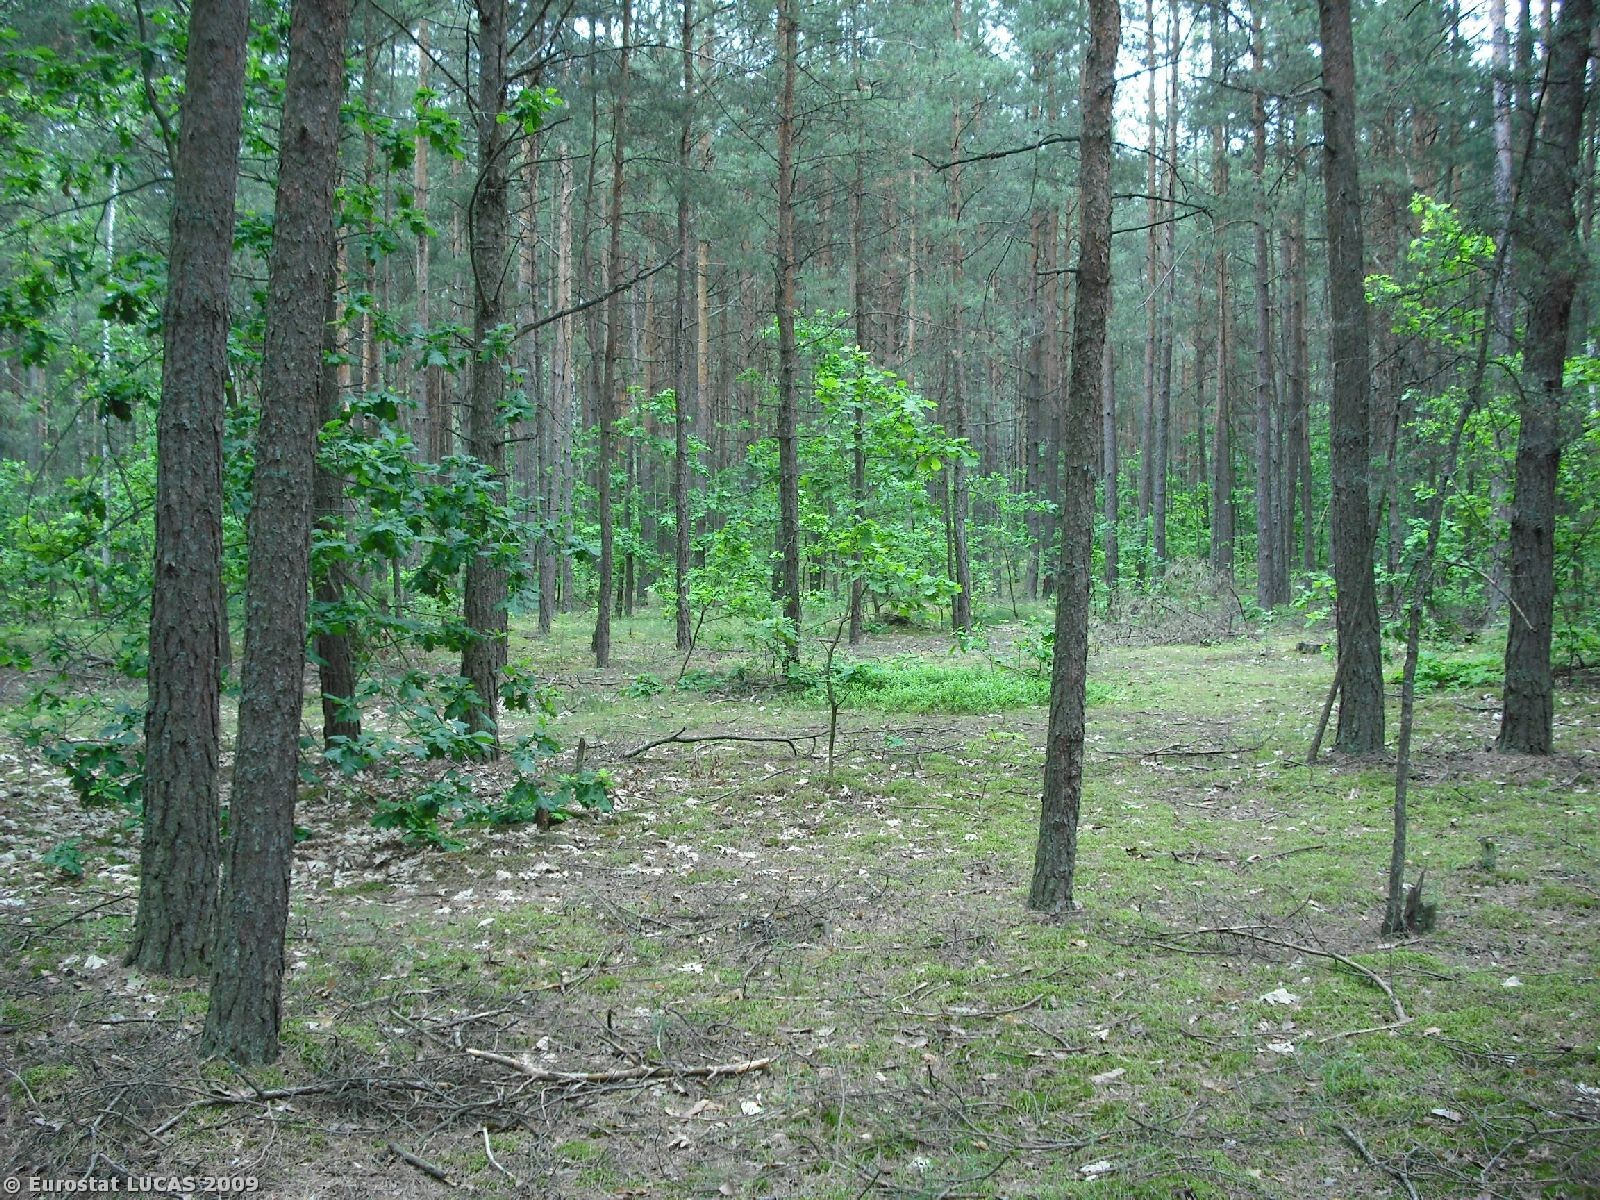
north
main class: Woodland
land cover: Coniferous woodland
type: hemiboreal forest and nemoral coniferous forest and mixed broadleaved-coniferous forest
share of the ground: > 75 %
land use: Forestry
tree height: > 5 m
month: June
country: PL
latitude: 52.7076
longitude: 22.3934
